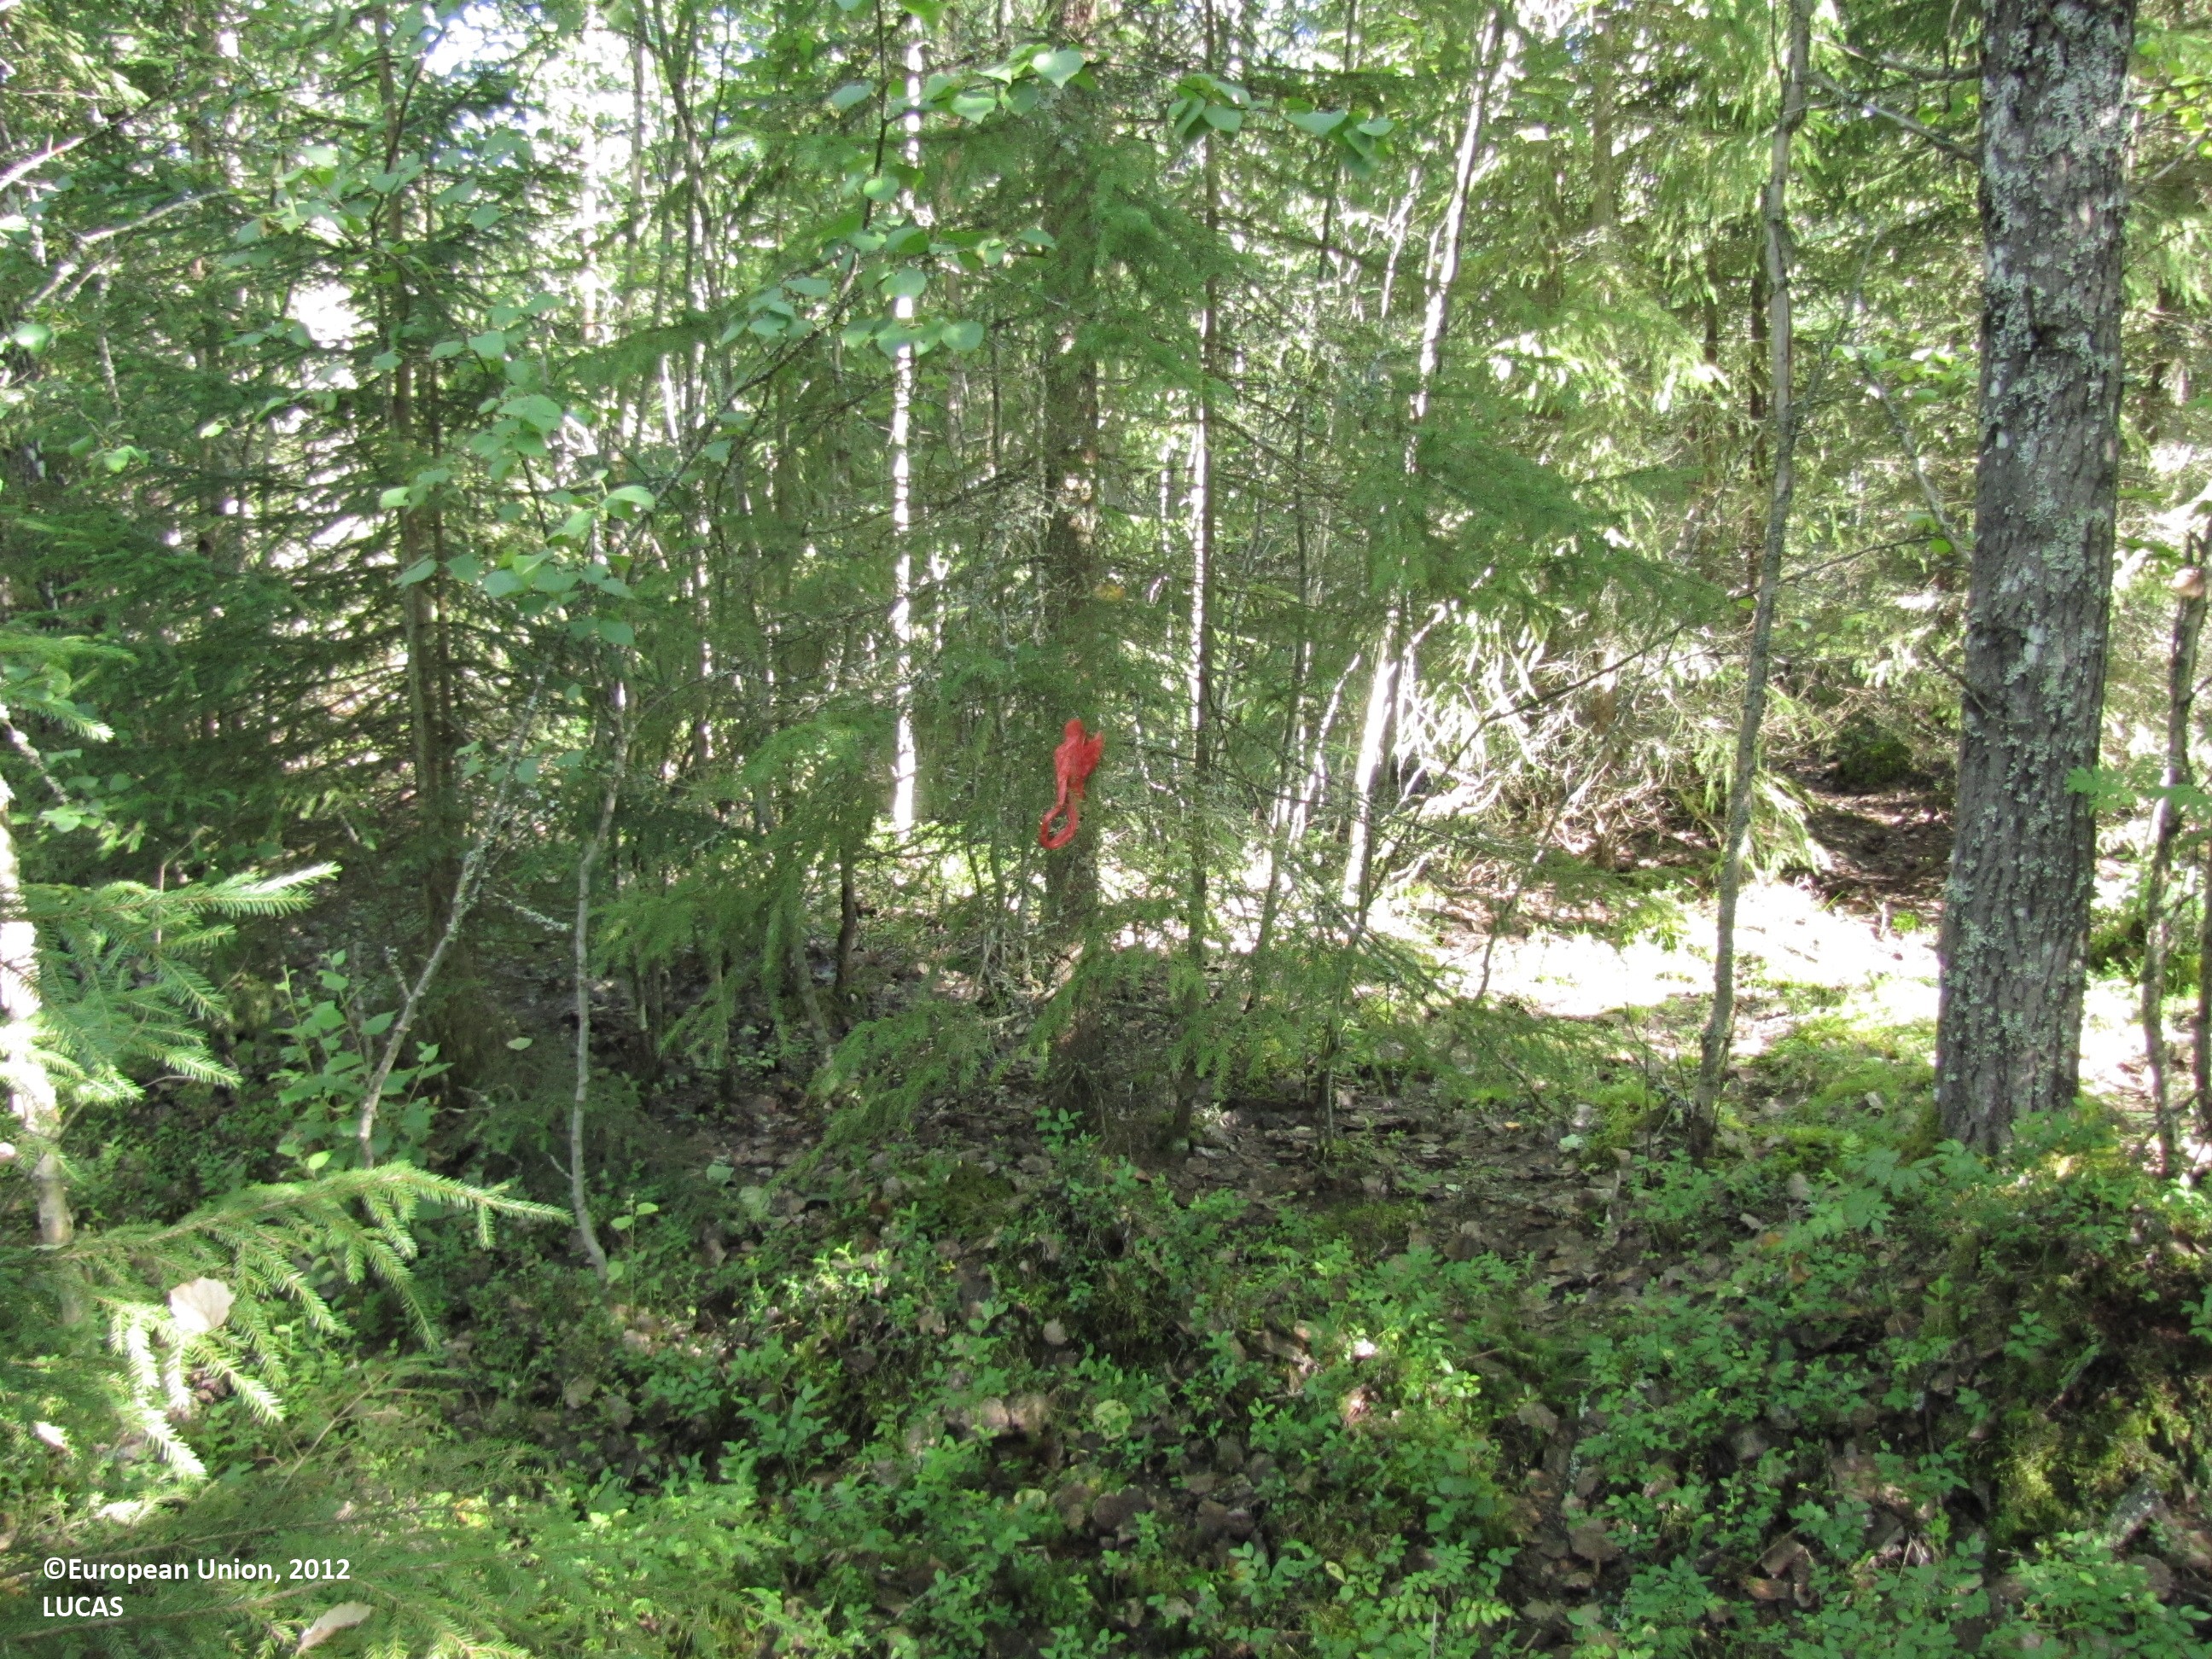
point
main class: Woodland
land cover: Other mixed woodland
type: boreal forest
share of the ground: > 75 %
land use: Forestry
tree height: > 5 m
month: July
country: FI
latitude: 62.0910
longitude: 23.1099
